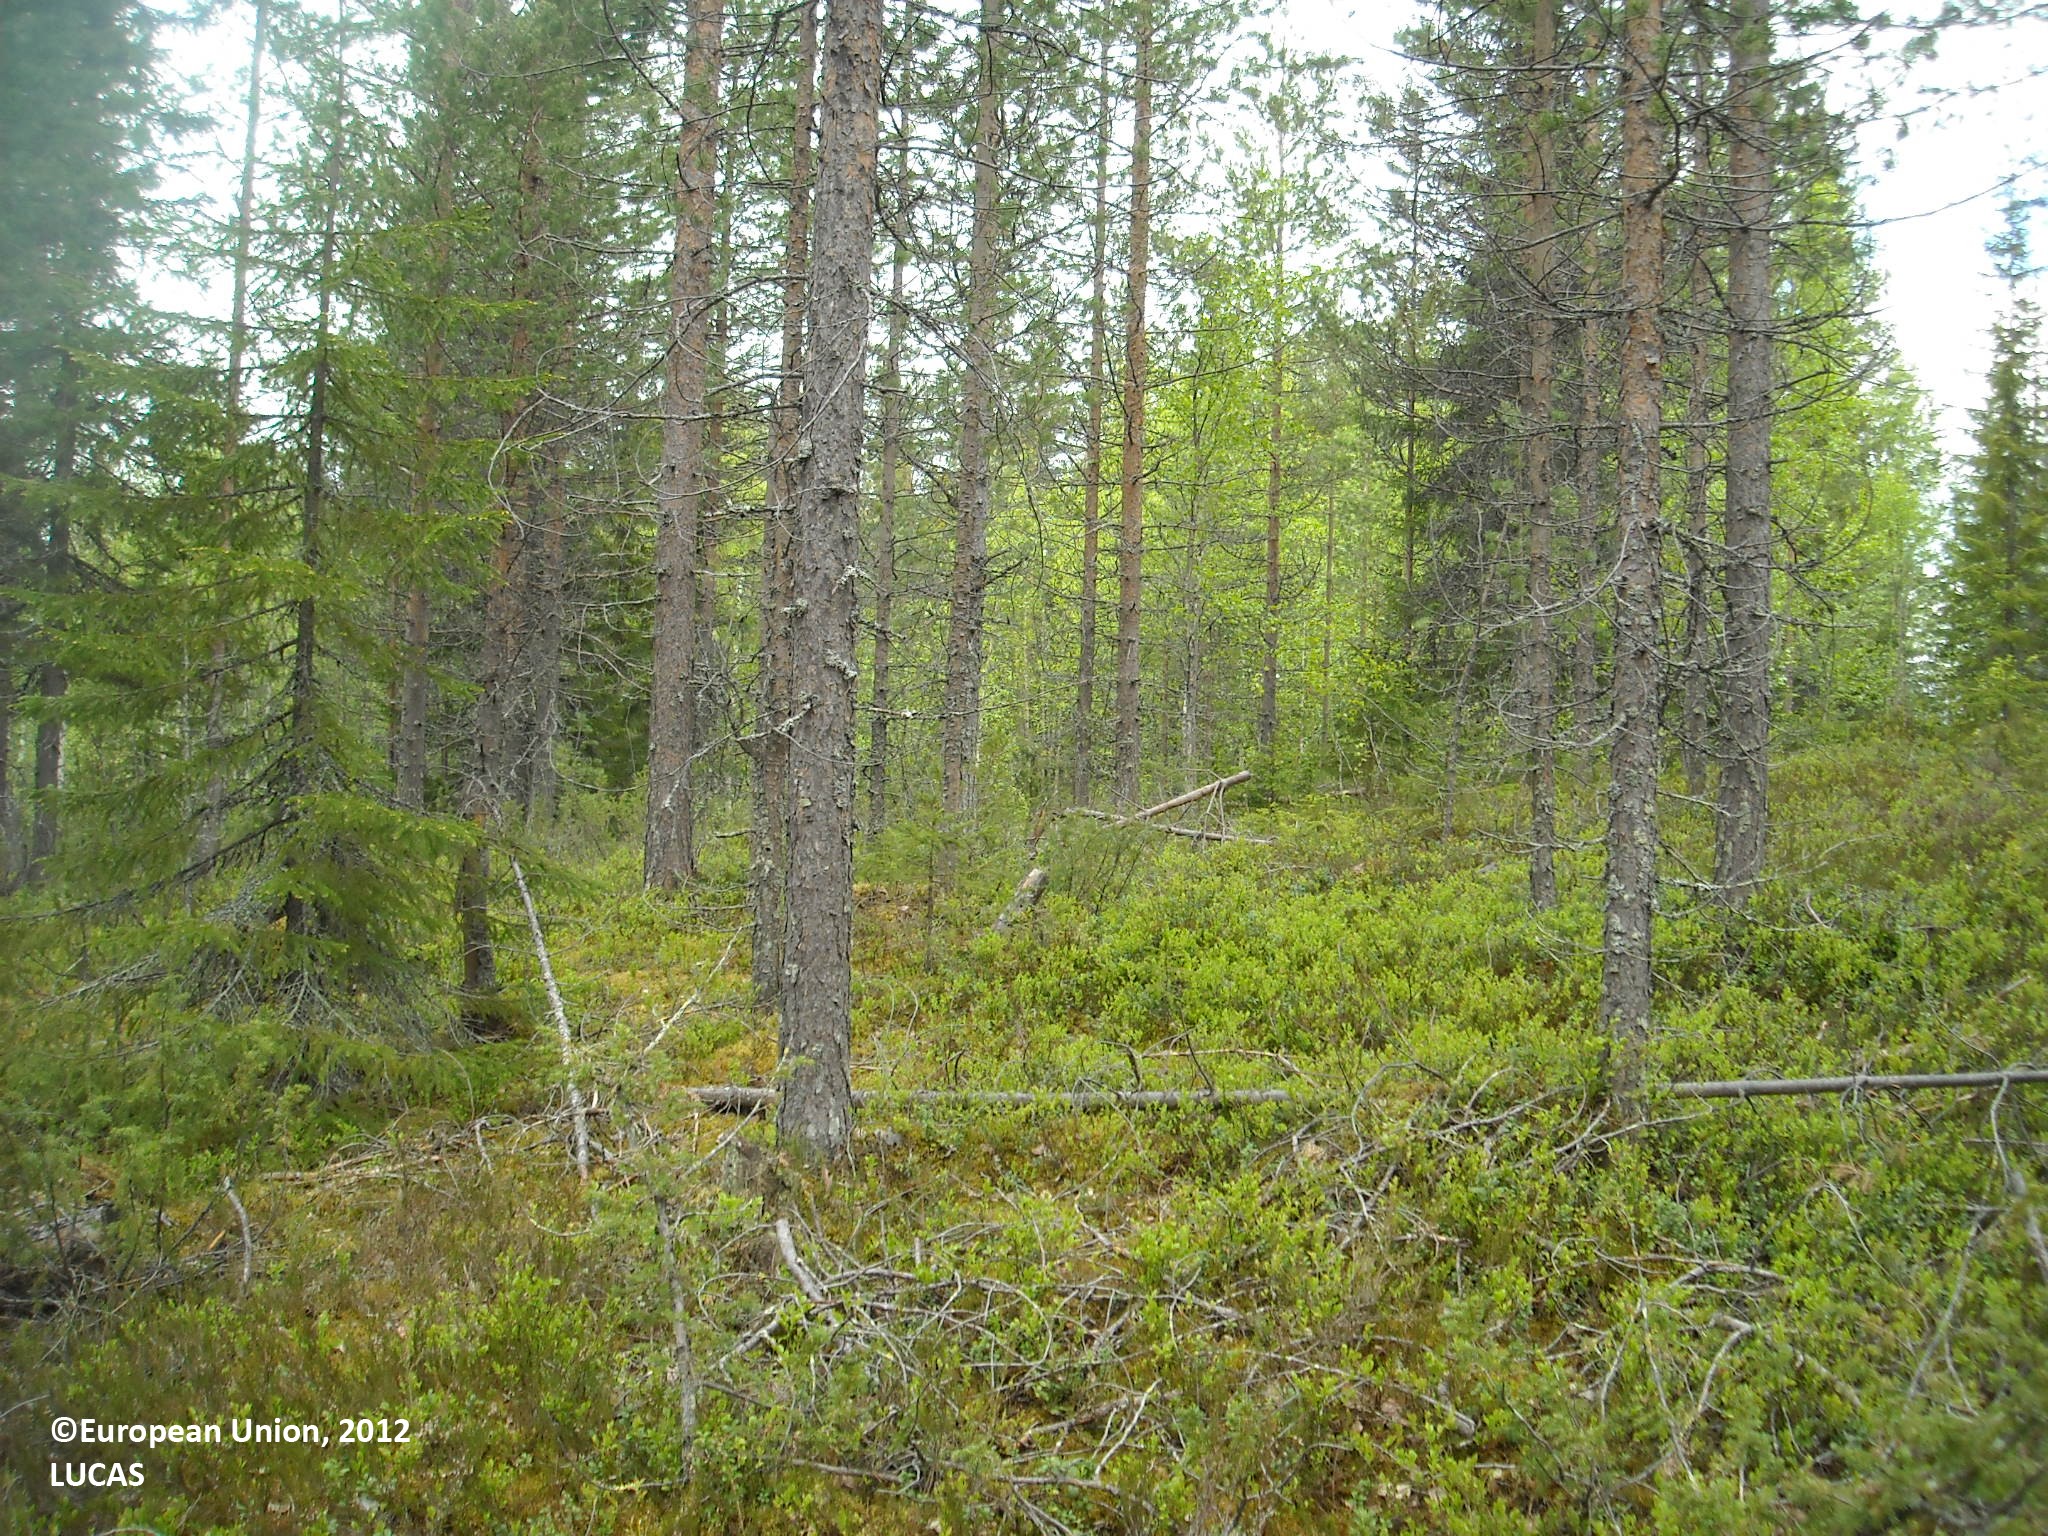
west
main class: Woodland
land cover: Other coniferous woodland
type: boreal forest
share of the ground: 50 - 75 %
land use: Forestry
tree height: > 5 m
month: June
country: FI
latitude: 65.2773
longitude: 27.8213
